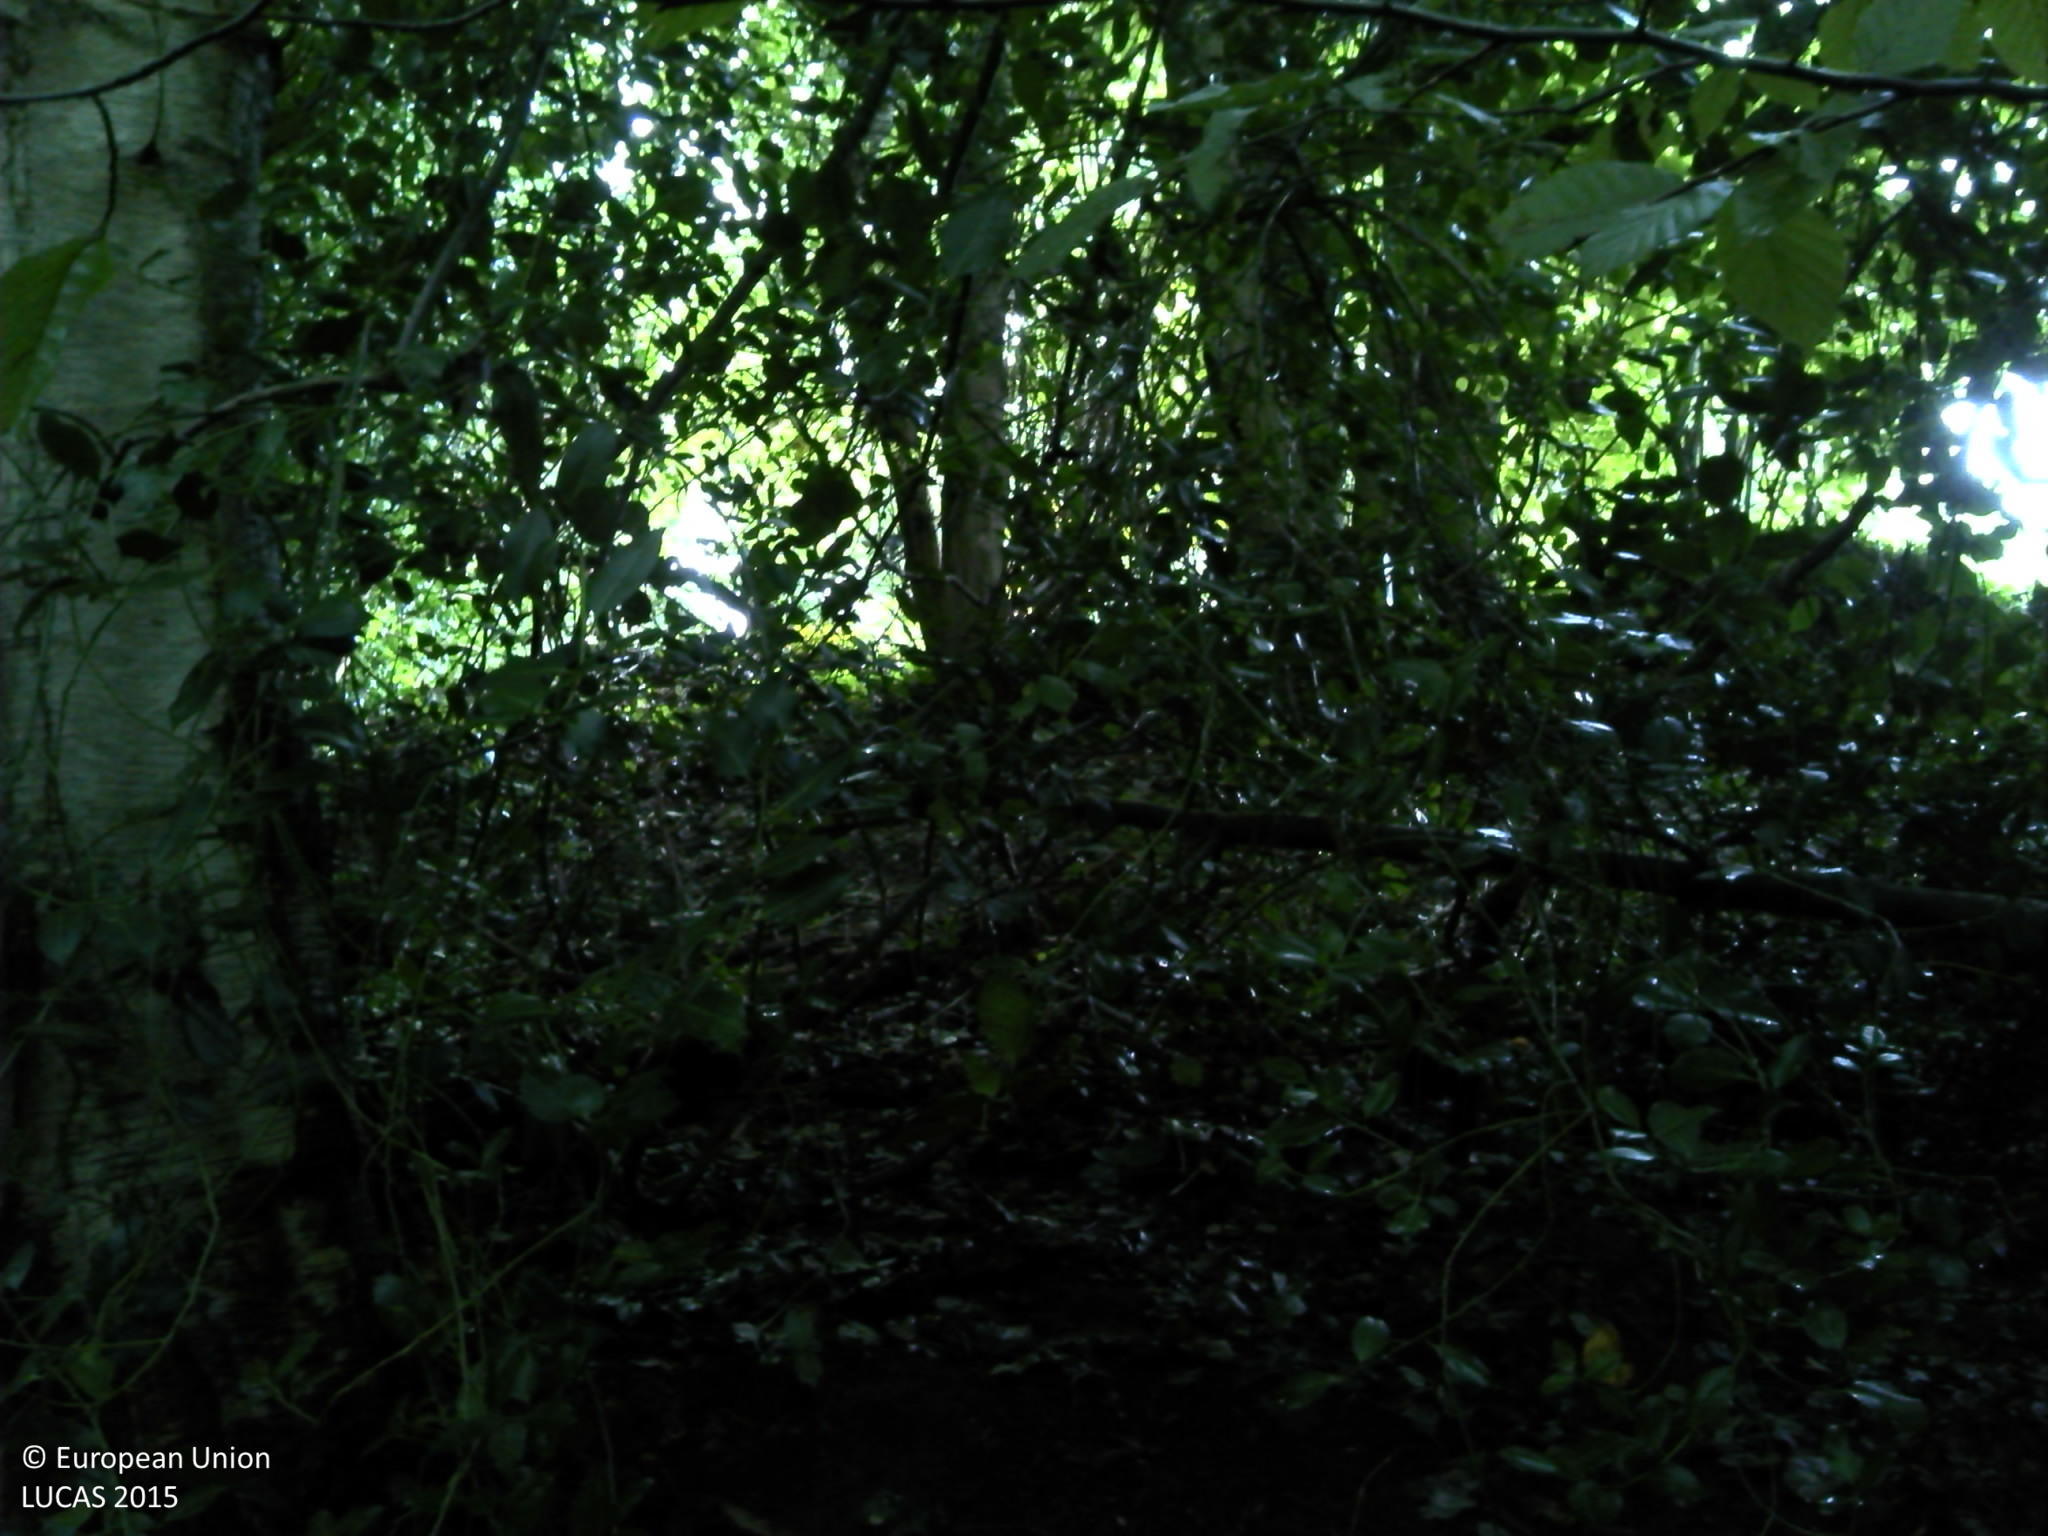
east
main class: Woodland
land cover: Broadleaved woodland
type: beech forest
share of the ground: > 75 %
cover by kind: broadleaved forest trees 100 %
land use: Forestry
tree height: > 5 m
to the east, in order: Broadleaved woodland; Artificial constructions in urban areas; Grassland with sparse tree/shrub cover
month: June
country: FR
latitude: 49.5175
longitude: 0.3163
